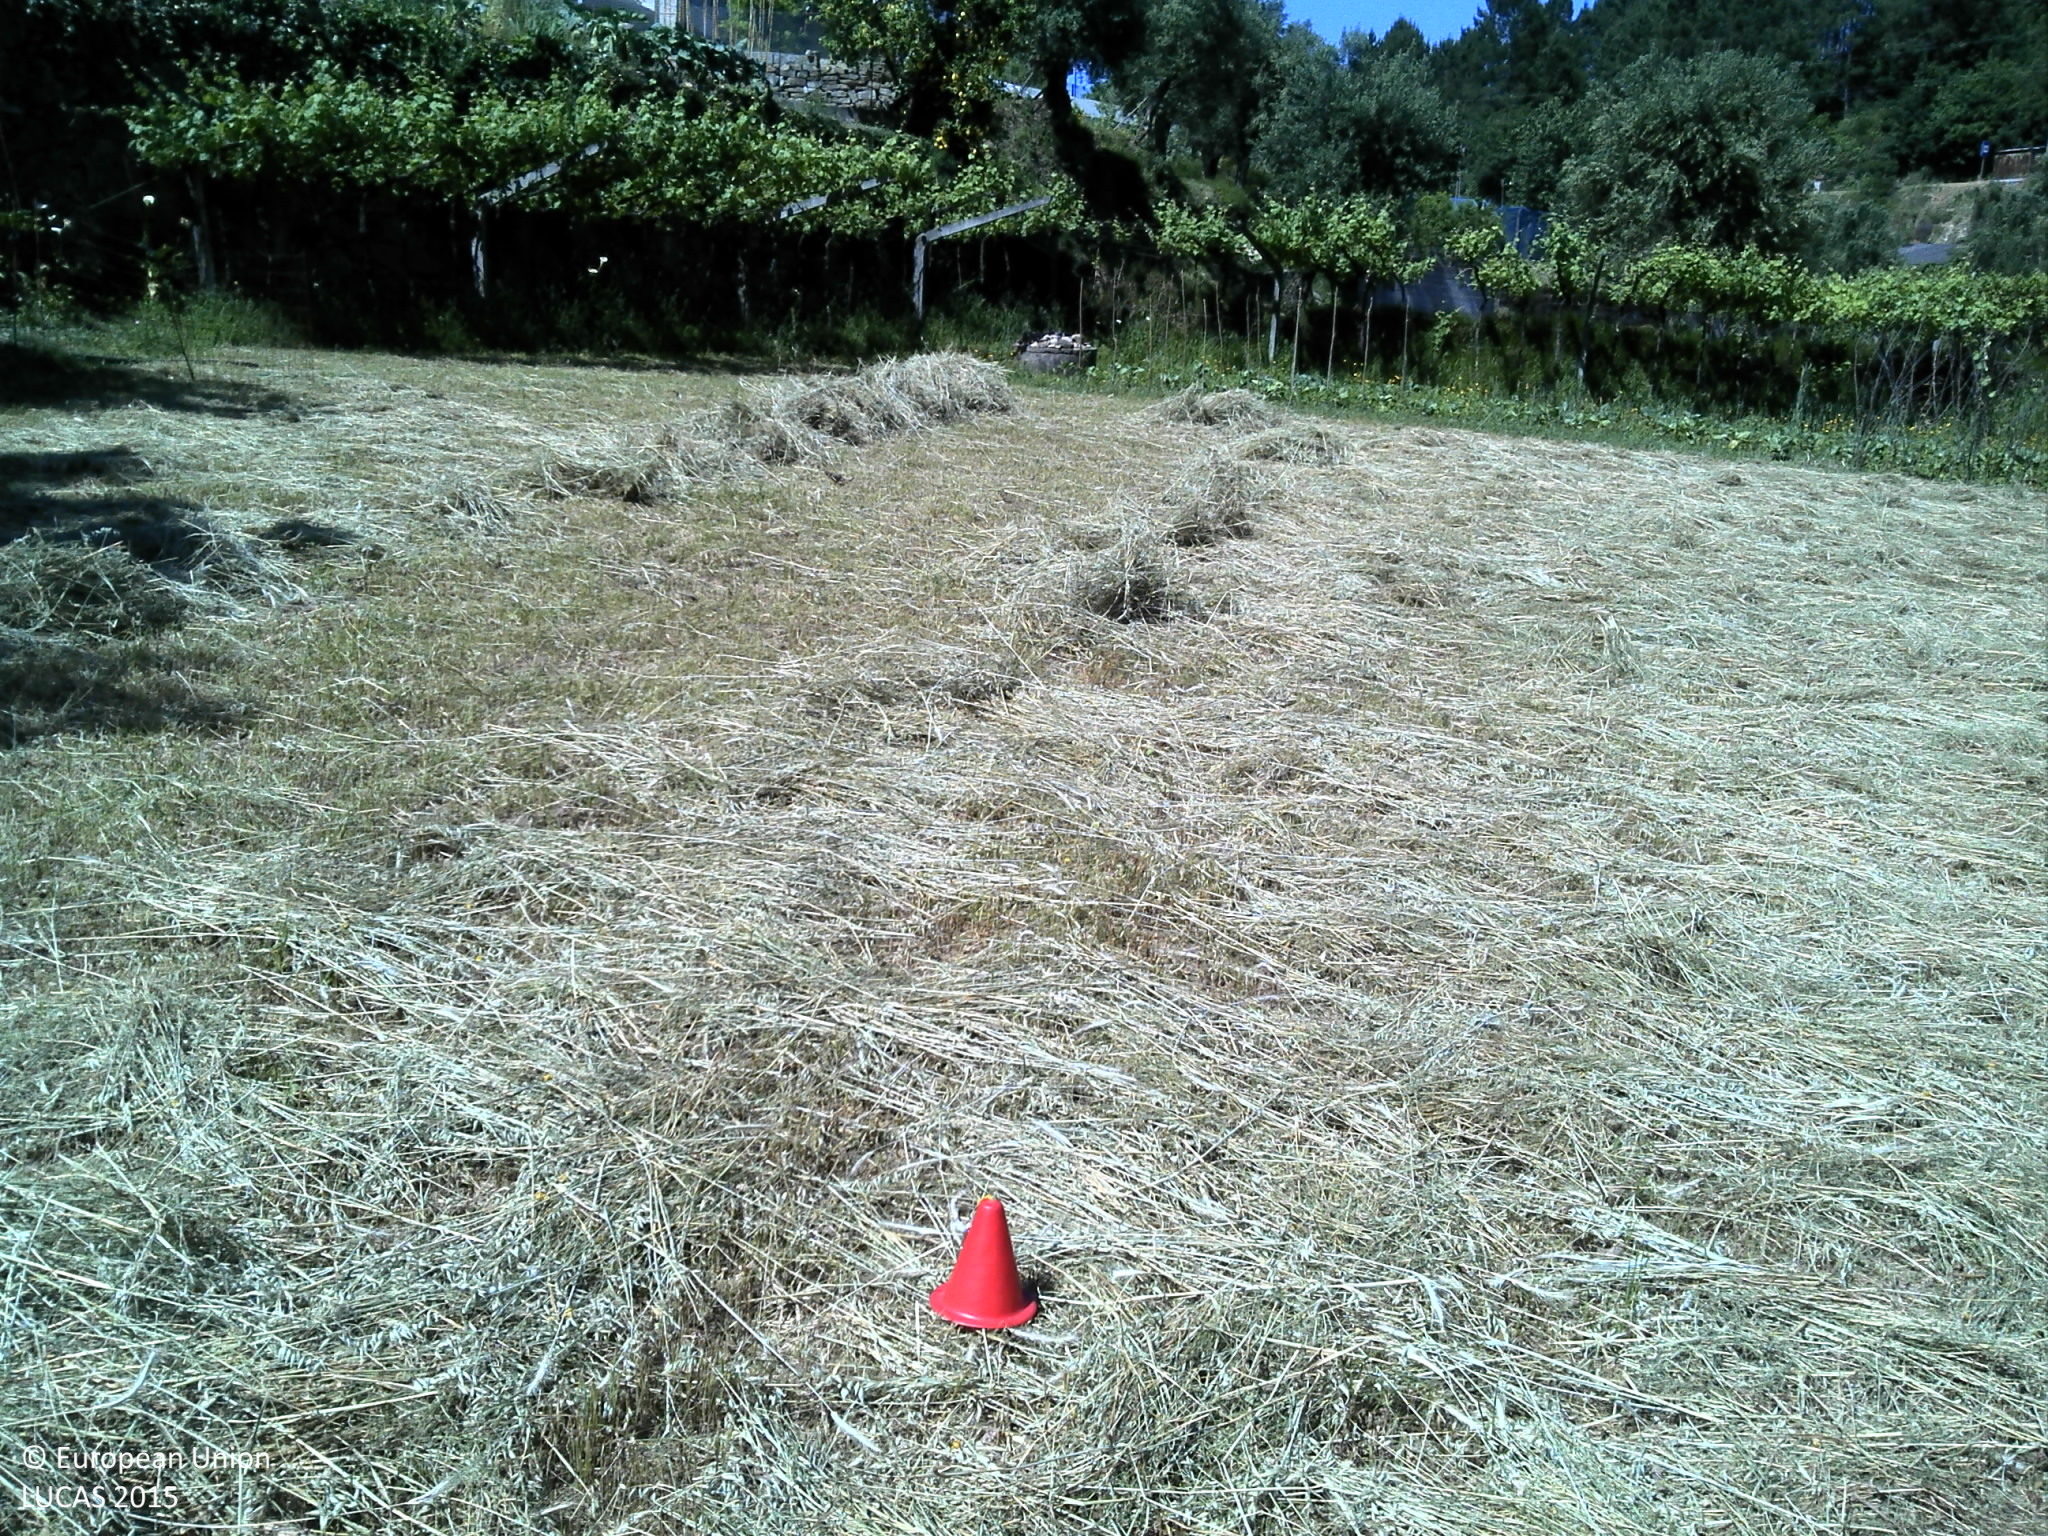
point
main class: Cropland
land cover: Temporary grasslands
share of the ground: 25 - 50 %
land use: Agriculture (excluding fallow land and kitchen gardens)
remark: Harvested field
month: May
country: PT
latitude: 41.6932
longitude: -8.5802
